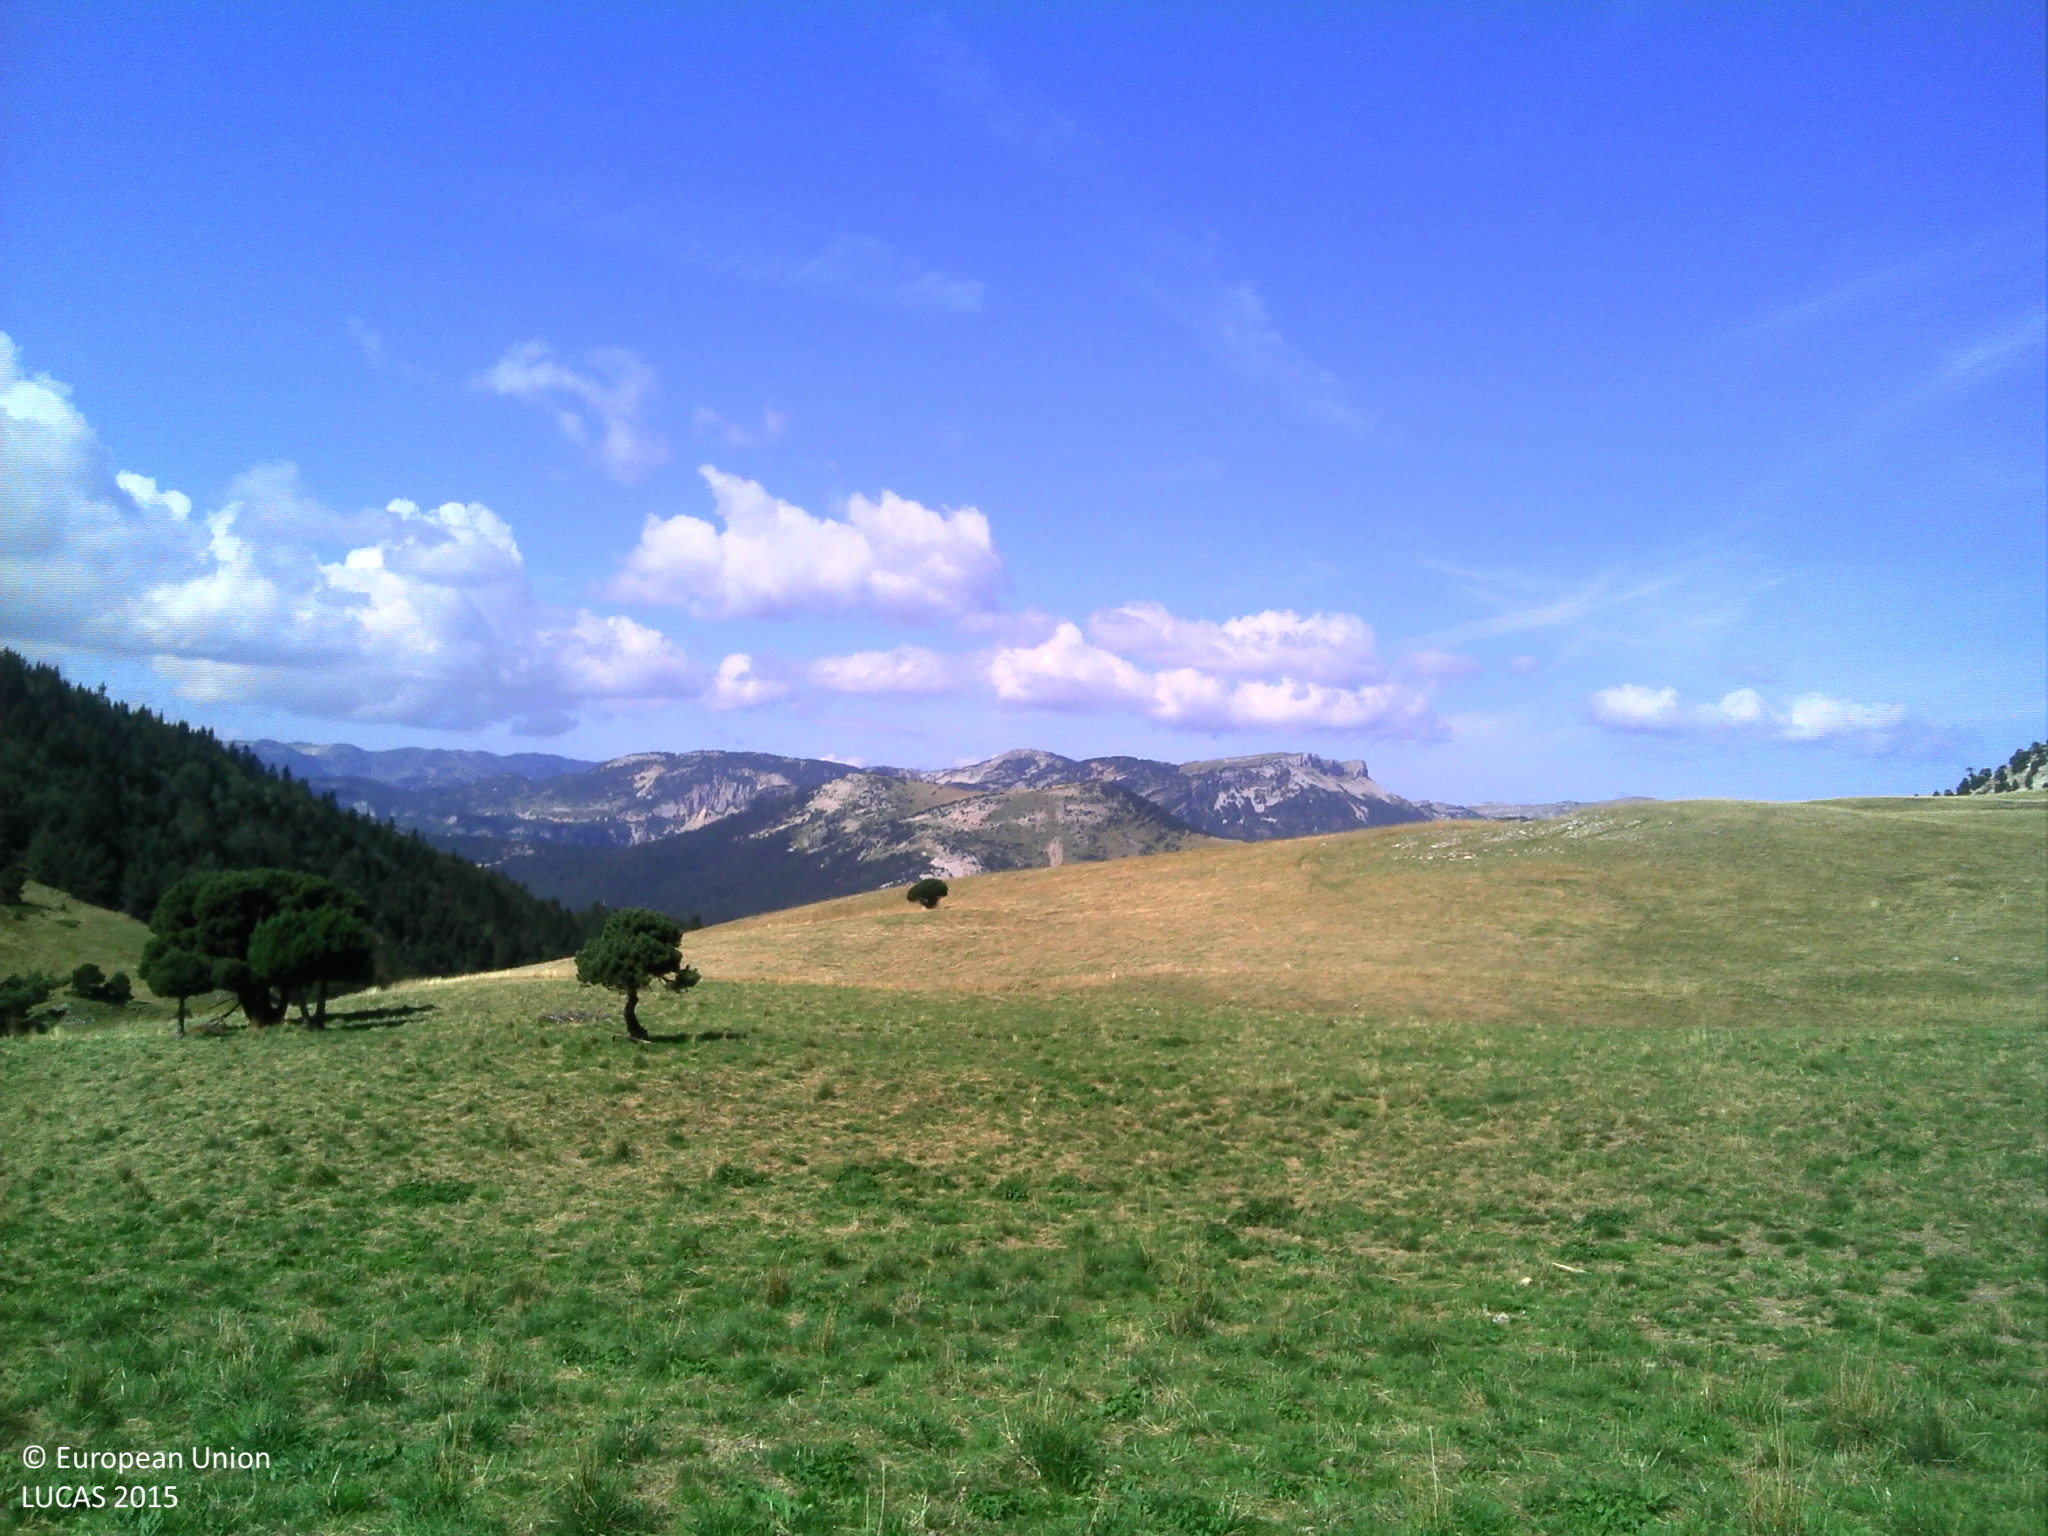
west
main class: Grassland
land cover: Grassland without tree/shrub cover
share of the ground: > 75 %
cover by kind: herbaceous plants 95 %, shrubs 5 %
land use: Agriculture (excluding fallow land and kitchen gardens)
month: September
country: FR
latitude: 44.7458
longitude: 5.6237
